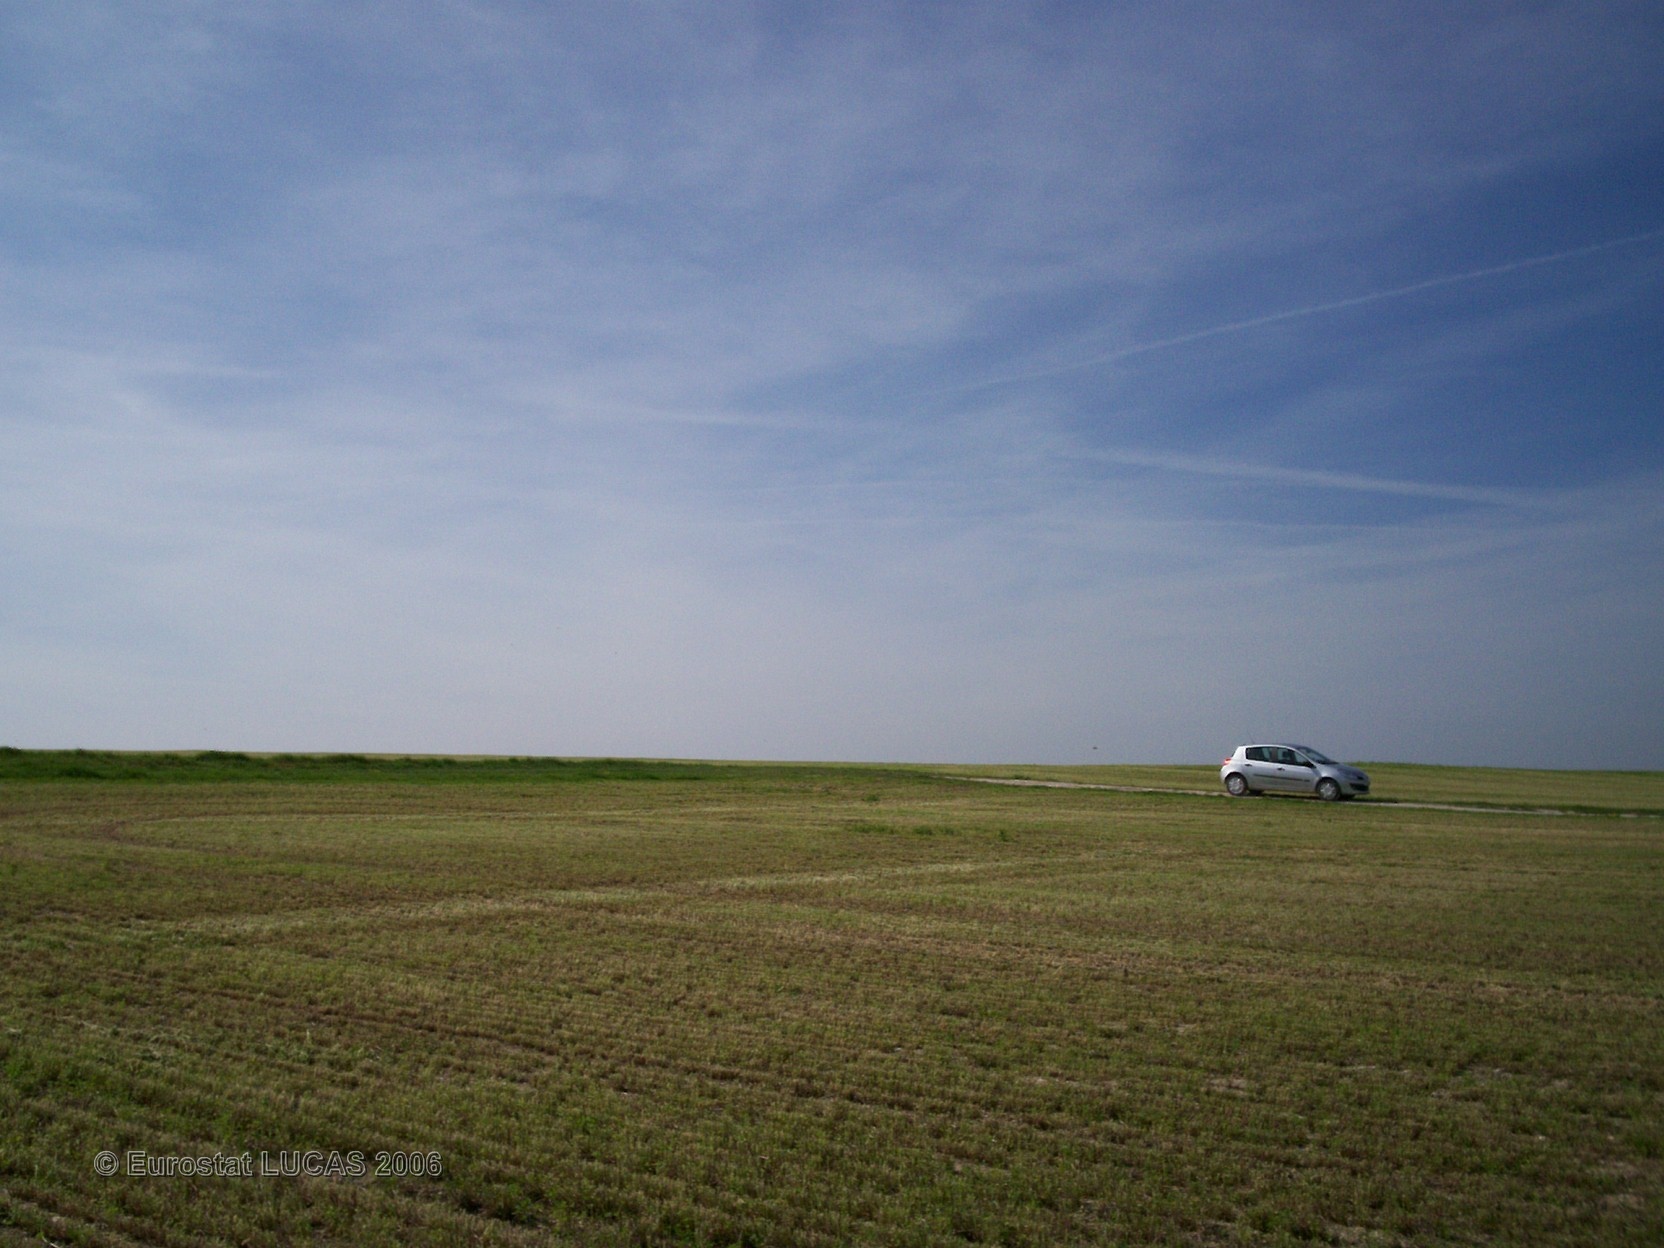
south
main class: Cropland
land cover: Lucerne
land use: Agriculture (excluding fallow land and kitchen gardens)
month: May
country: FR
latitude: 48.8399
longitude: 4.4239
